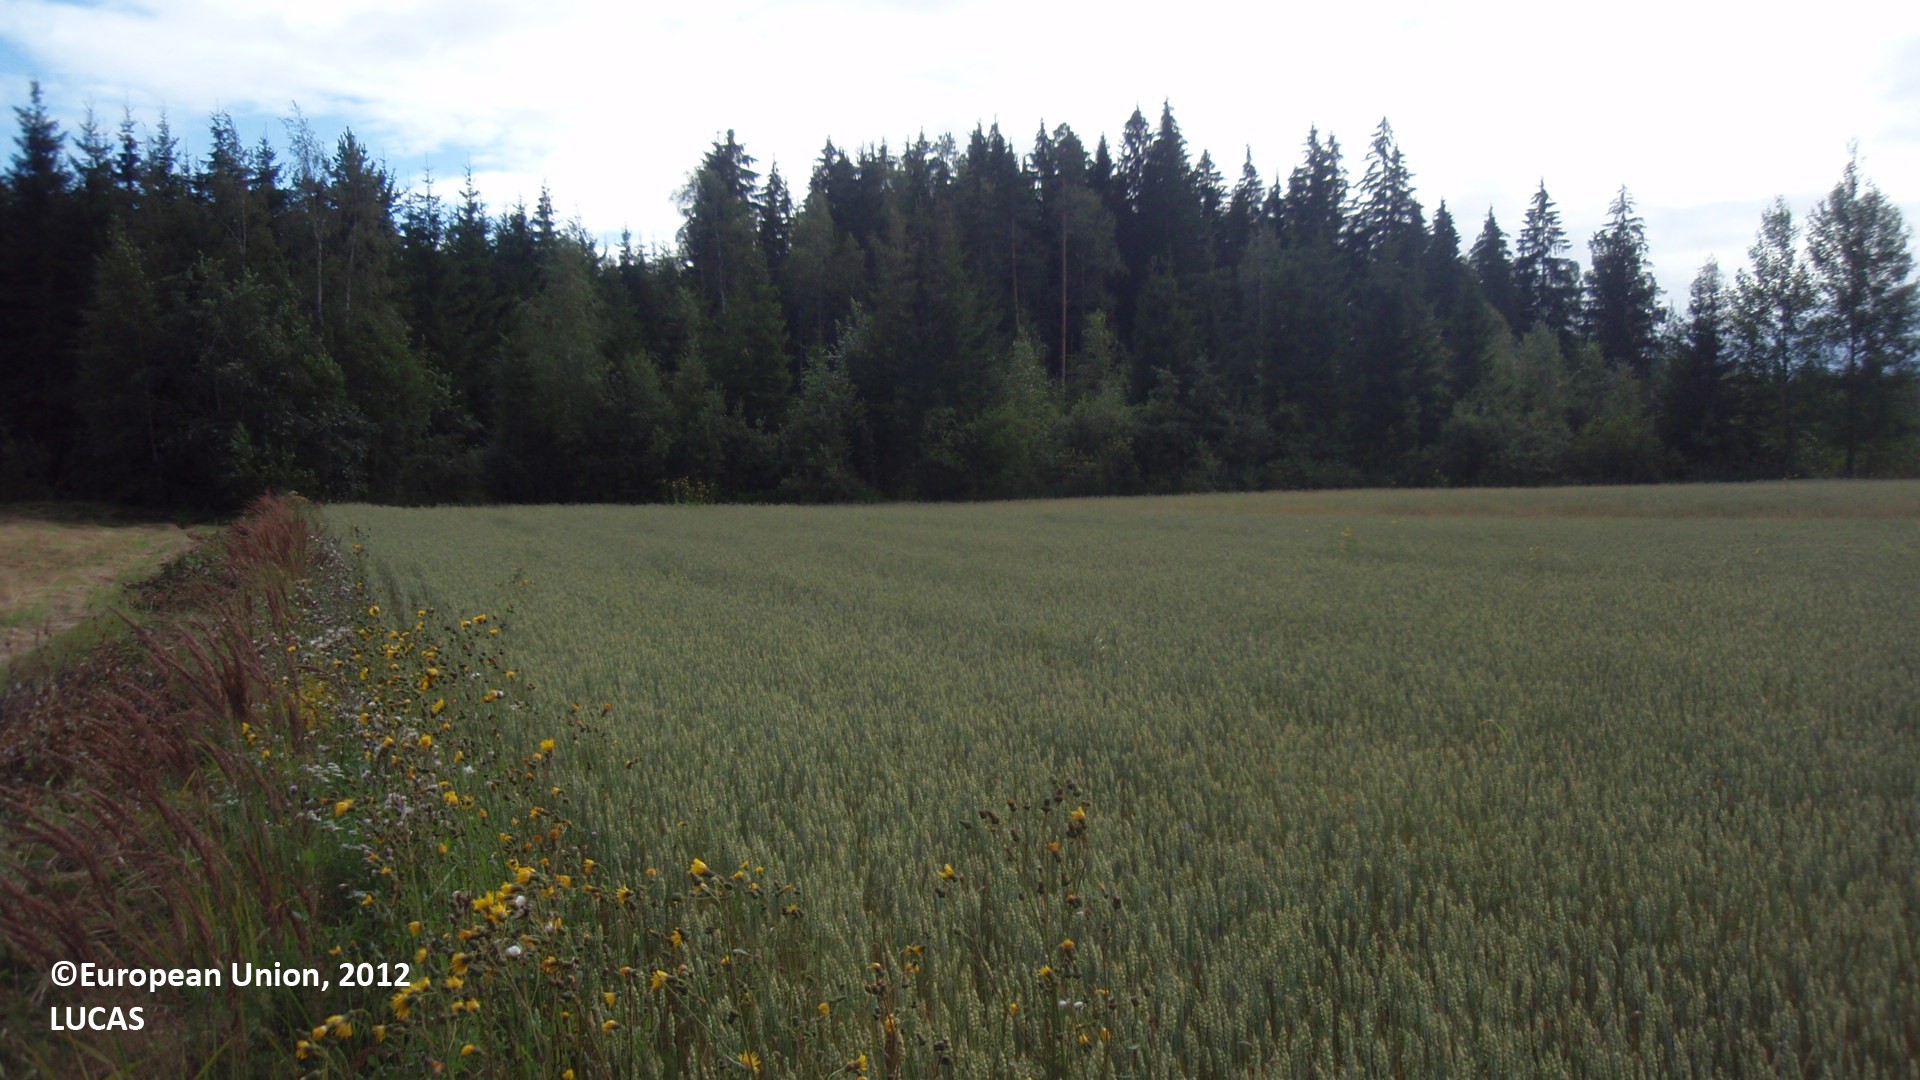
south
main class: Cropland
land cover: Common wheat
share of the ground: > 75 %
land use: Agriculture (excluding fallow land and kitchen gardens)
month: August
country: FI
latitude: 61.0766
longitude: 27.0151
